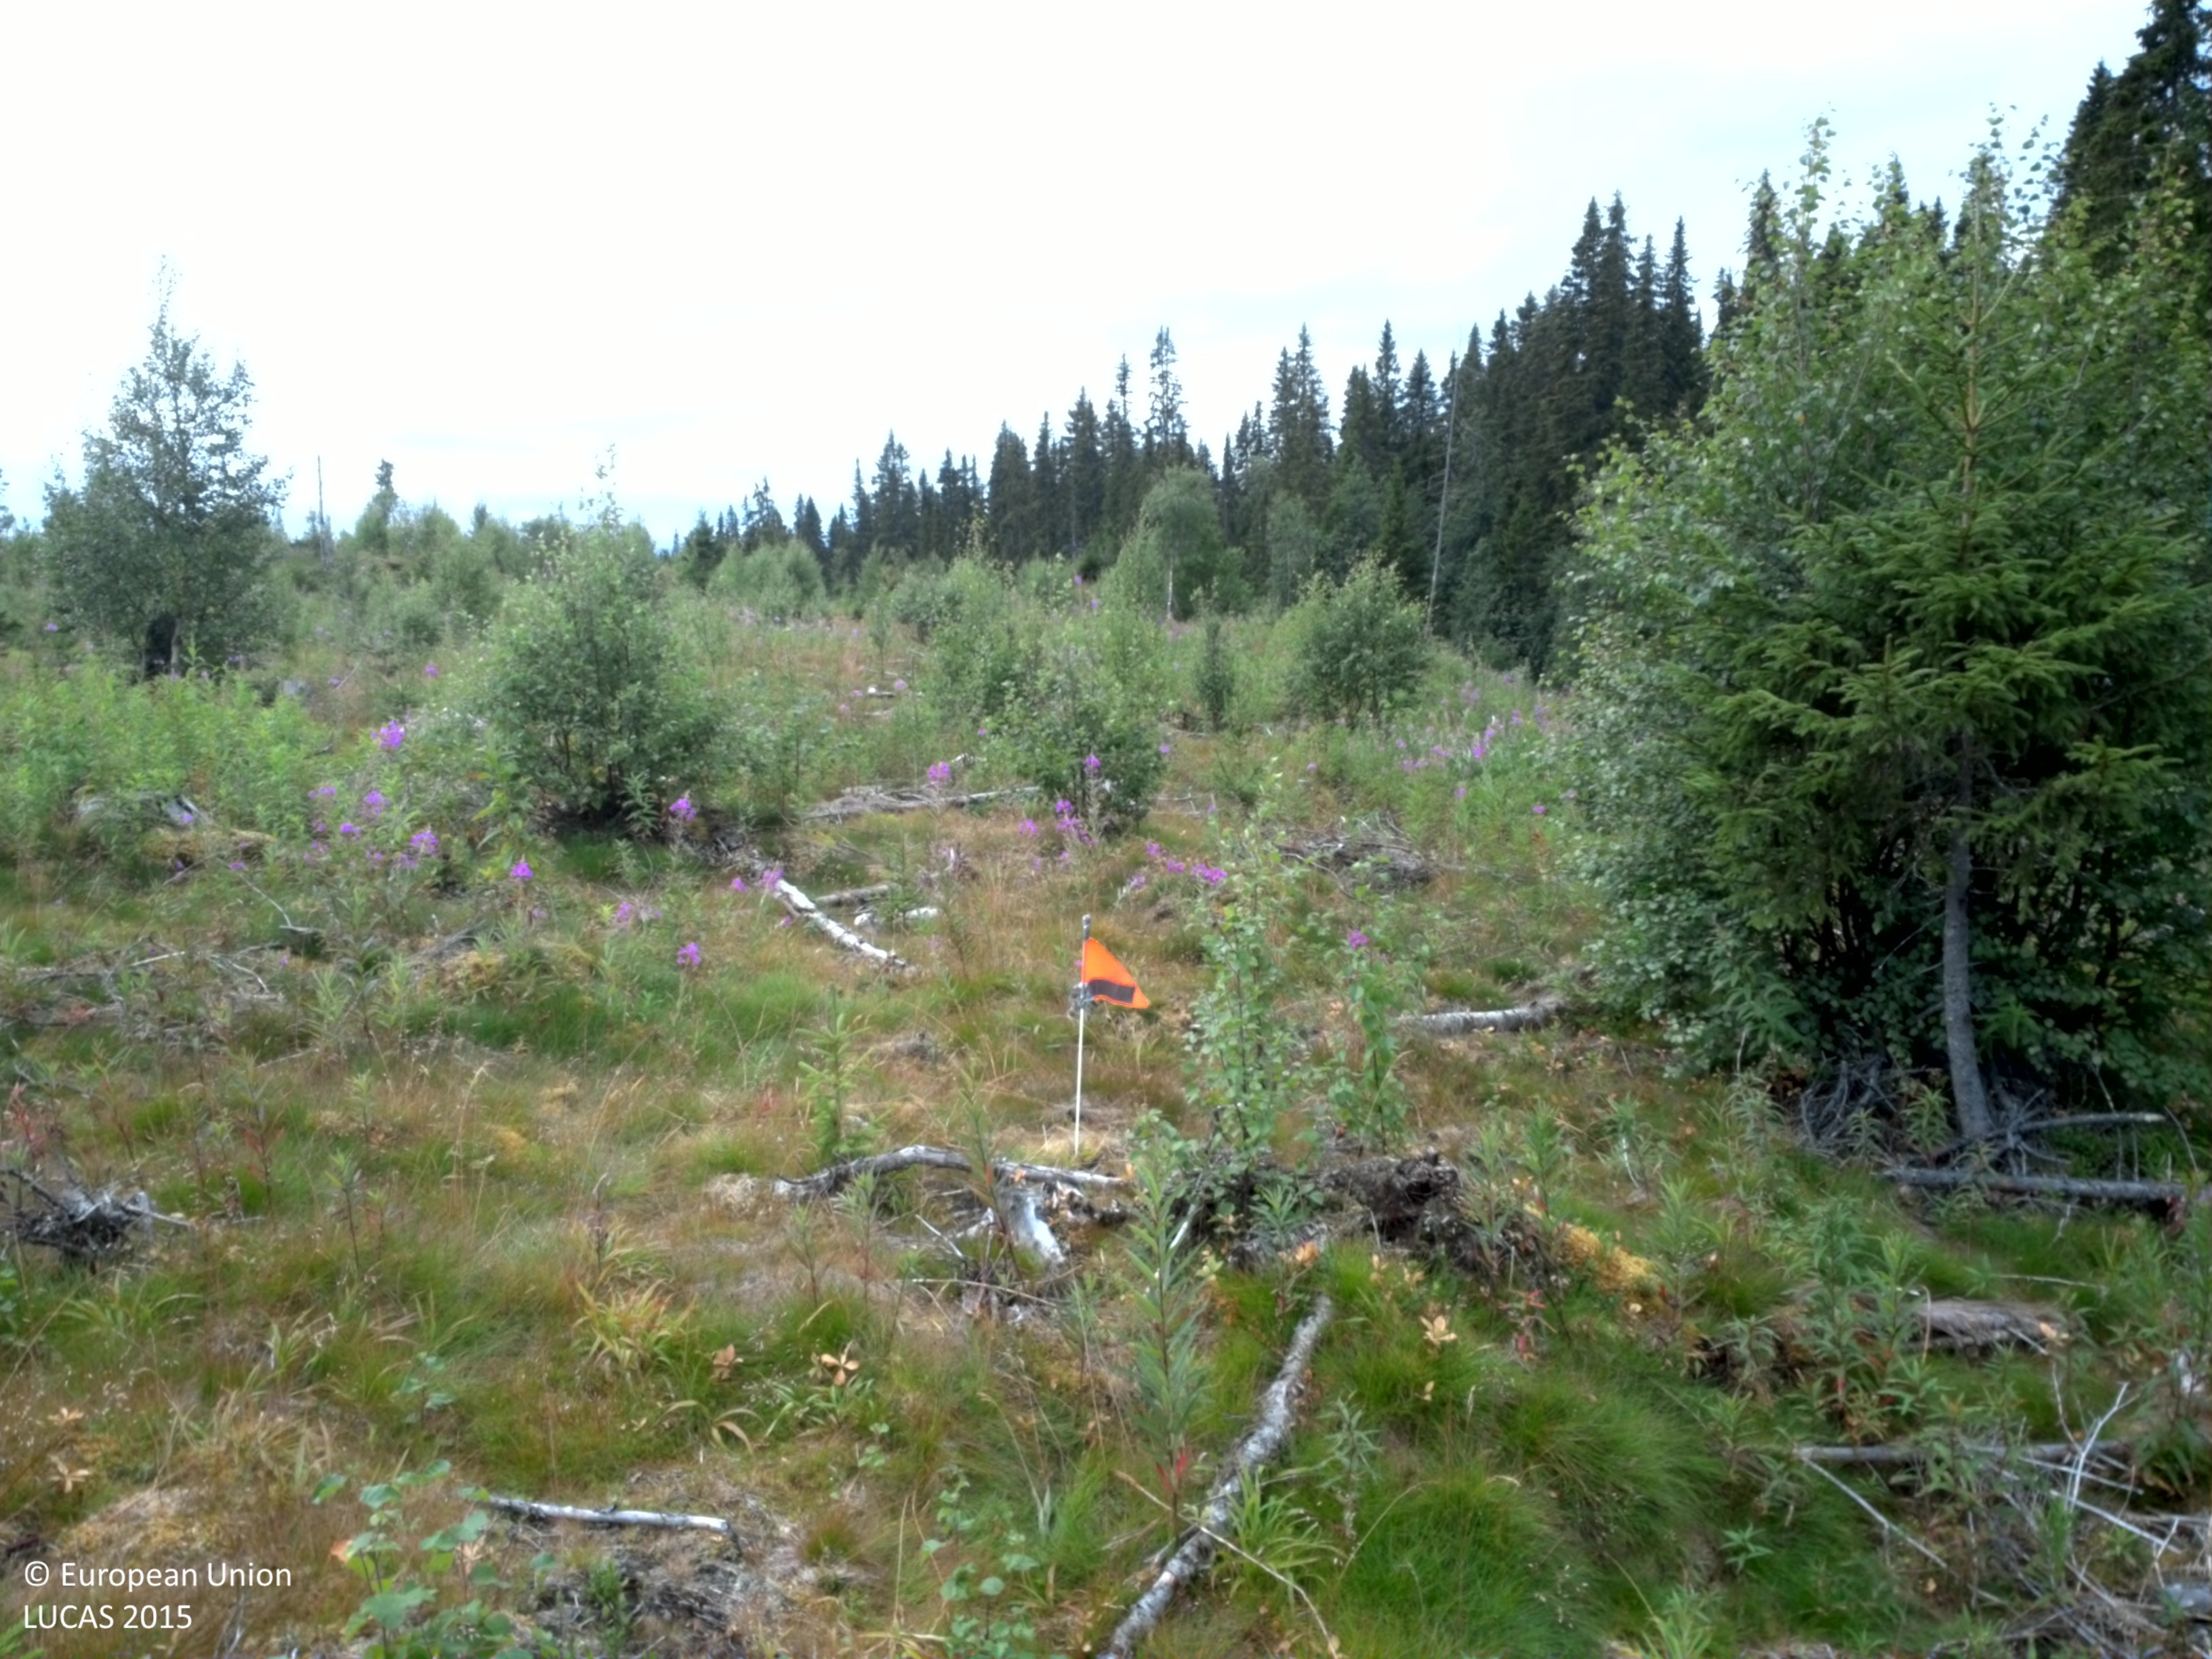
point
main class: Grassland
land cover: Grassland with sparse tree/shrub cover
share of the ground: > 75 %
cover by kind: herbaceous plants 80 %, broadleaved forest trees 5 %, shrubs 5 %, lichens and mosses 5 %
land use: Forestry
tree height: < 5 m
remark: Clear cut
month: August
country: SE
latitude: 64.7869
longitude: 16.5933
